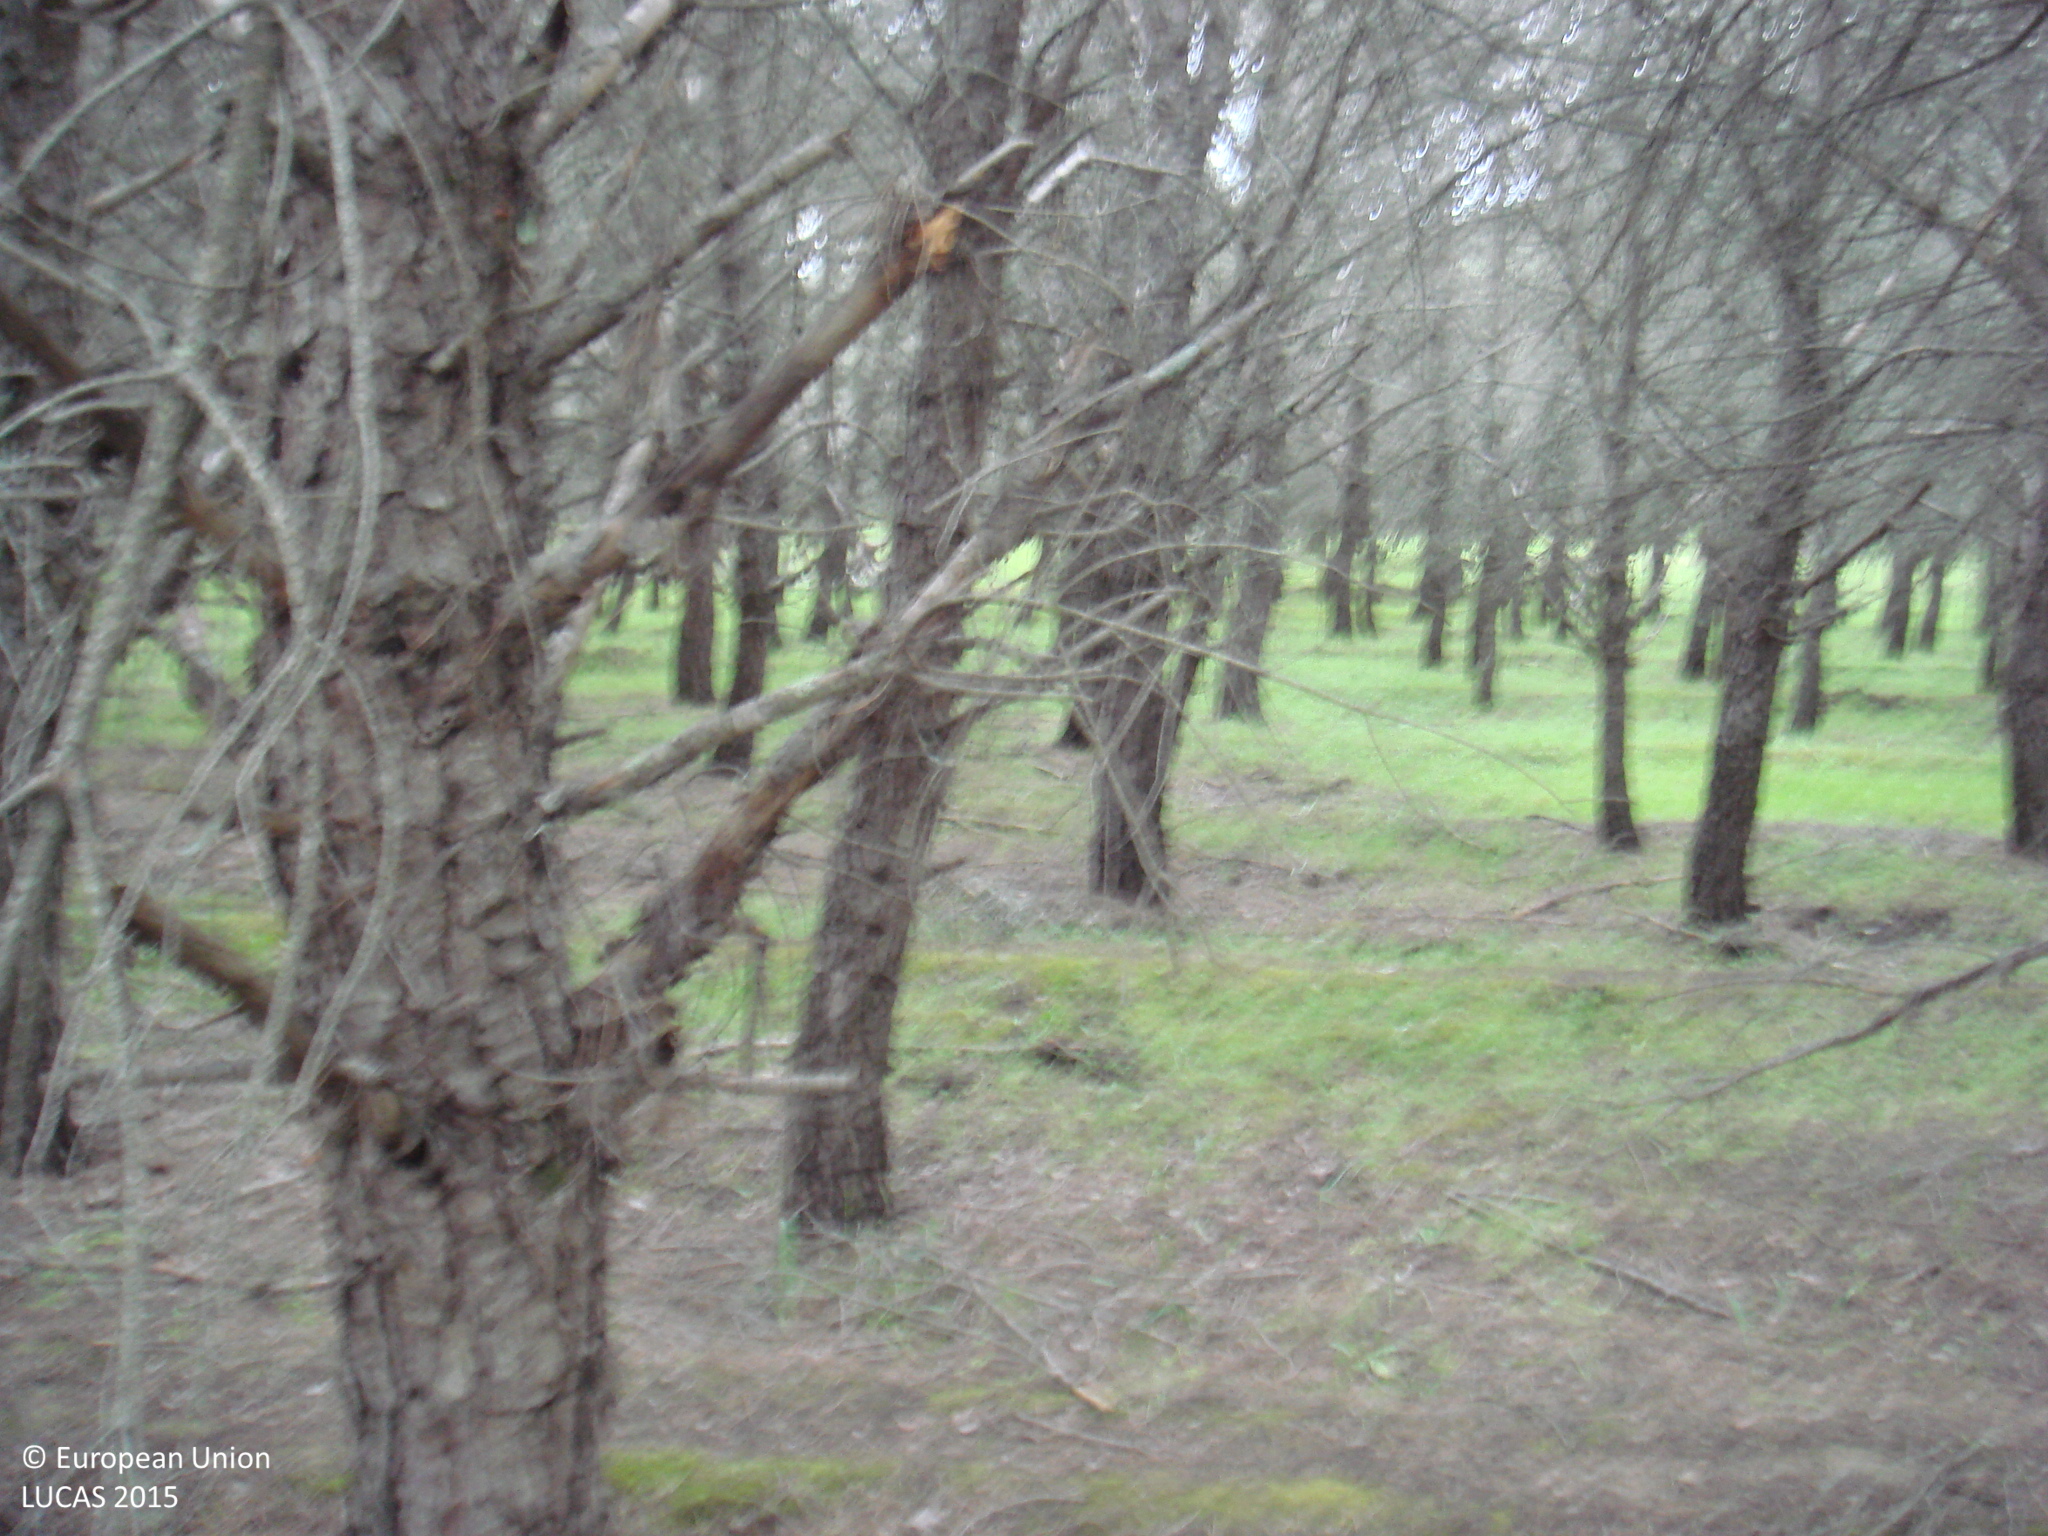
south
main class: Woodland
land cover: Pine dominated coniferous woodland
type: coniferous forest of the mediterranean region
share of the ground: > 75 %
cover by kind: coniferous forest trees 60 %, lichens and mosses 40 %
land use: Forestry
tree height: > 5 m
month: April
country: ES
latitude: 38.1503
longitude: -5.0050
